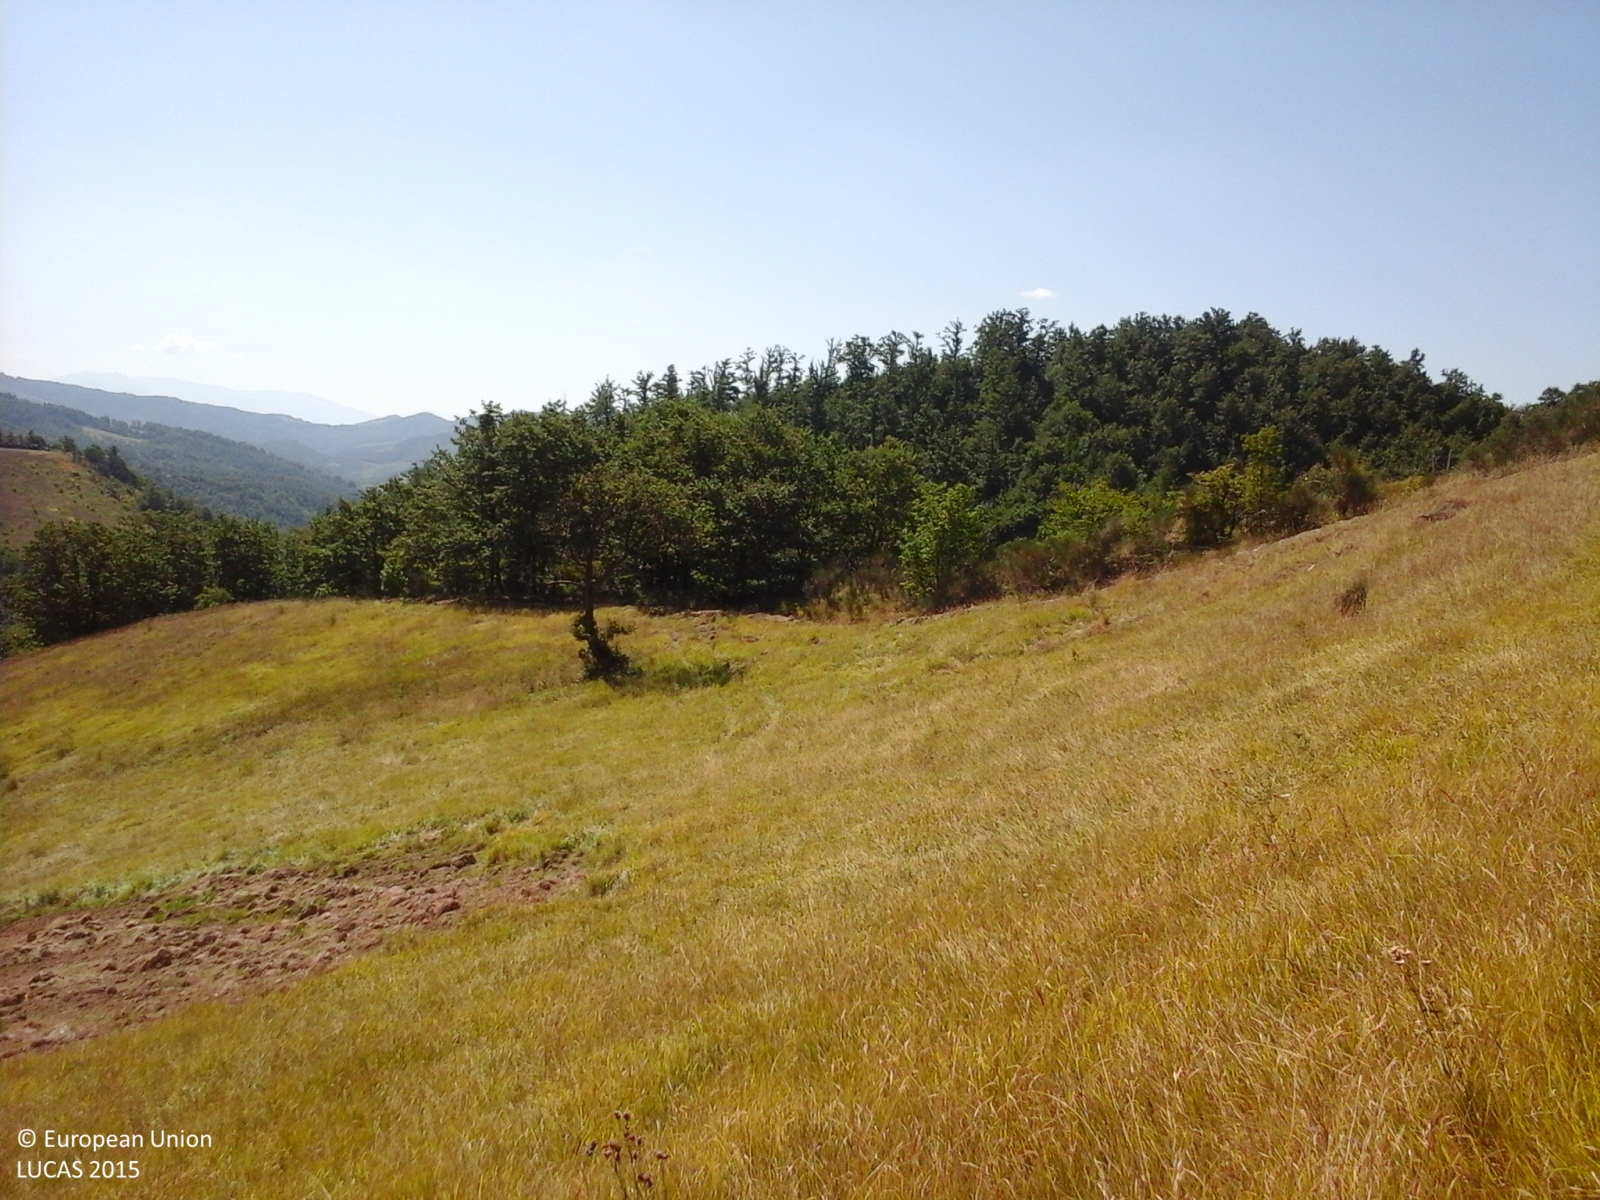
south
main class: Grassland
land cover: Grassland without tree/shrub cover
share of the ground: > 75 %
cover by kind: herbaceous plants 100 %
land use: Agriculture (excluding fallow land and kitchen gardens)
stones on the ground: 10 - 25 %
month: August
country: IT
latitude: 43.4528
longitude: 12.5513
